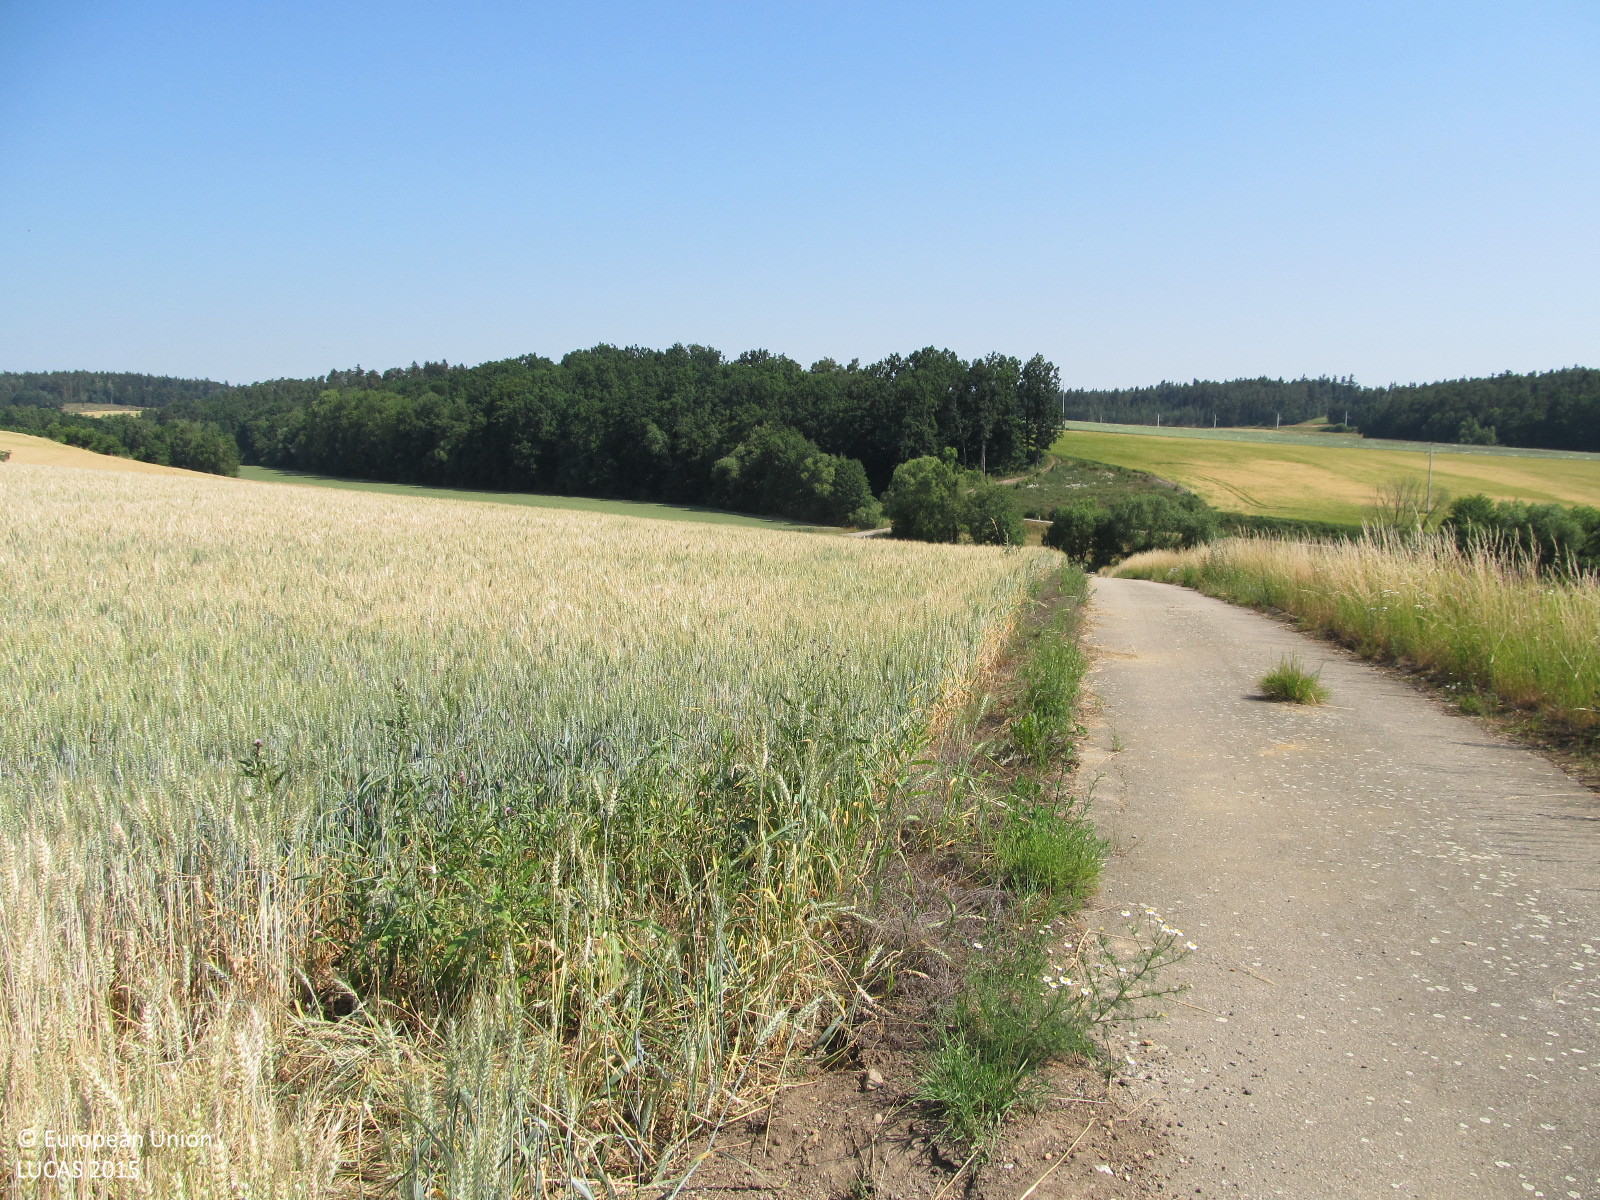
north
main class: Cropland
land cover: Common wheat
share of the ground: > 75 %
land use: Agriculture (excluding fallow land and kitchen gardens)
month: July
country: AT
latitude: 48.7268
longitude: 15.6724
